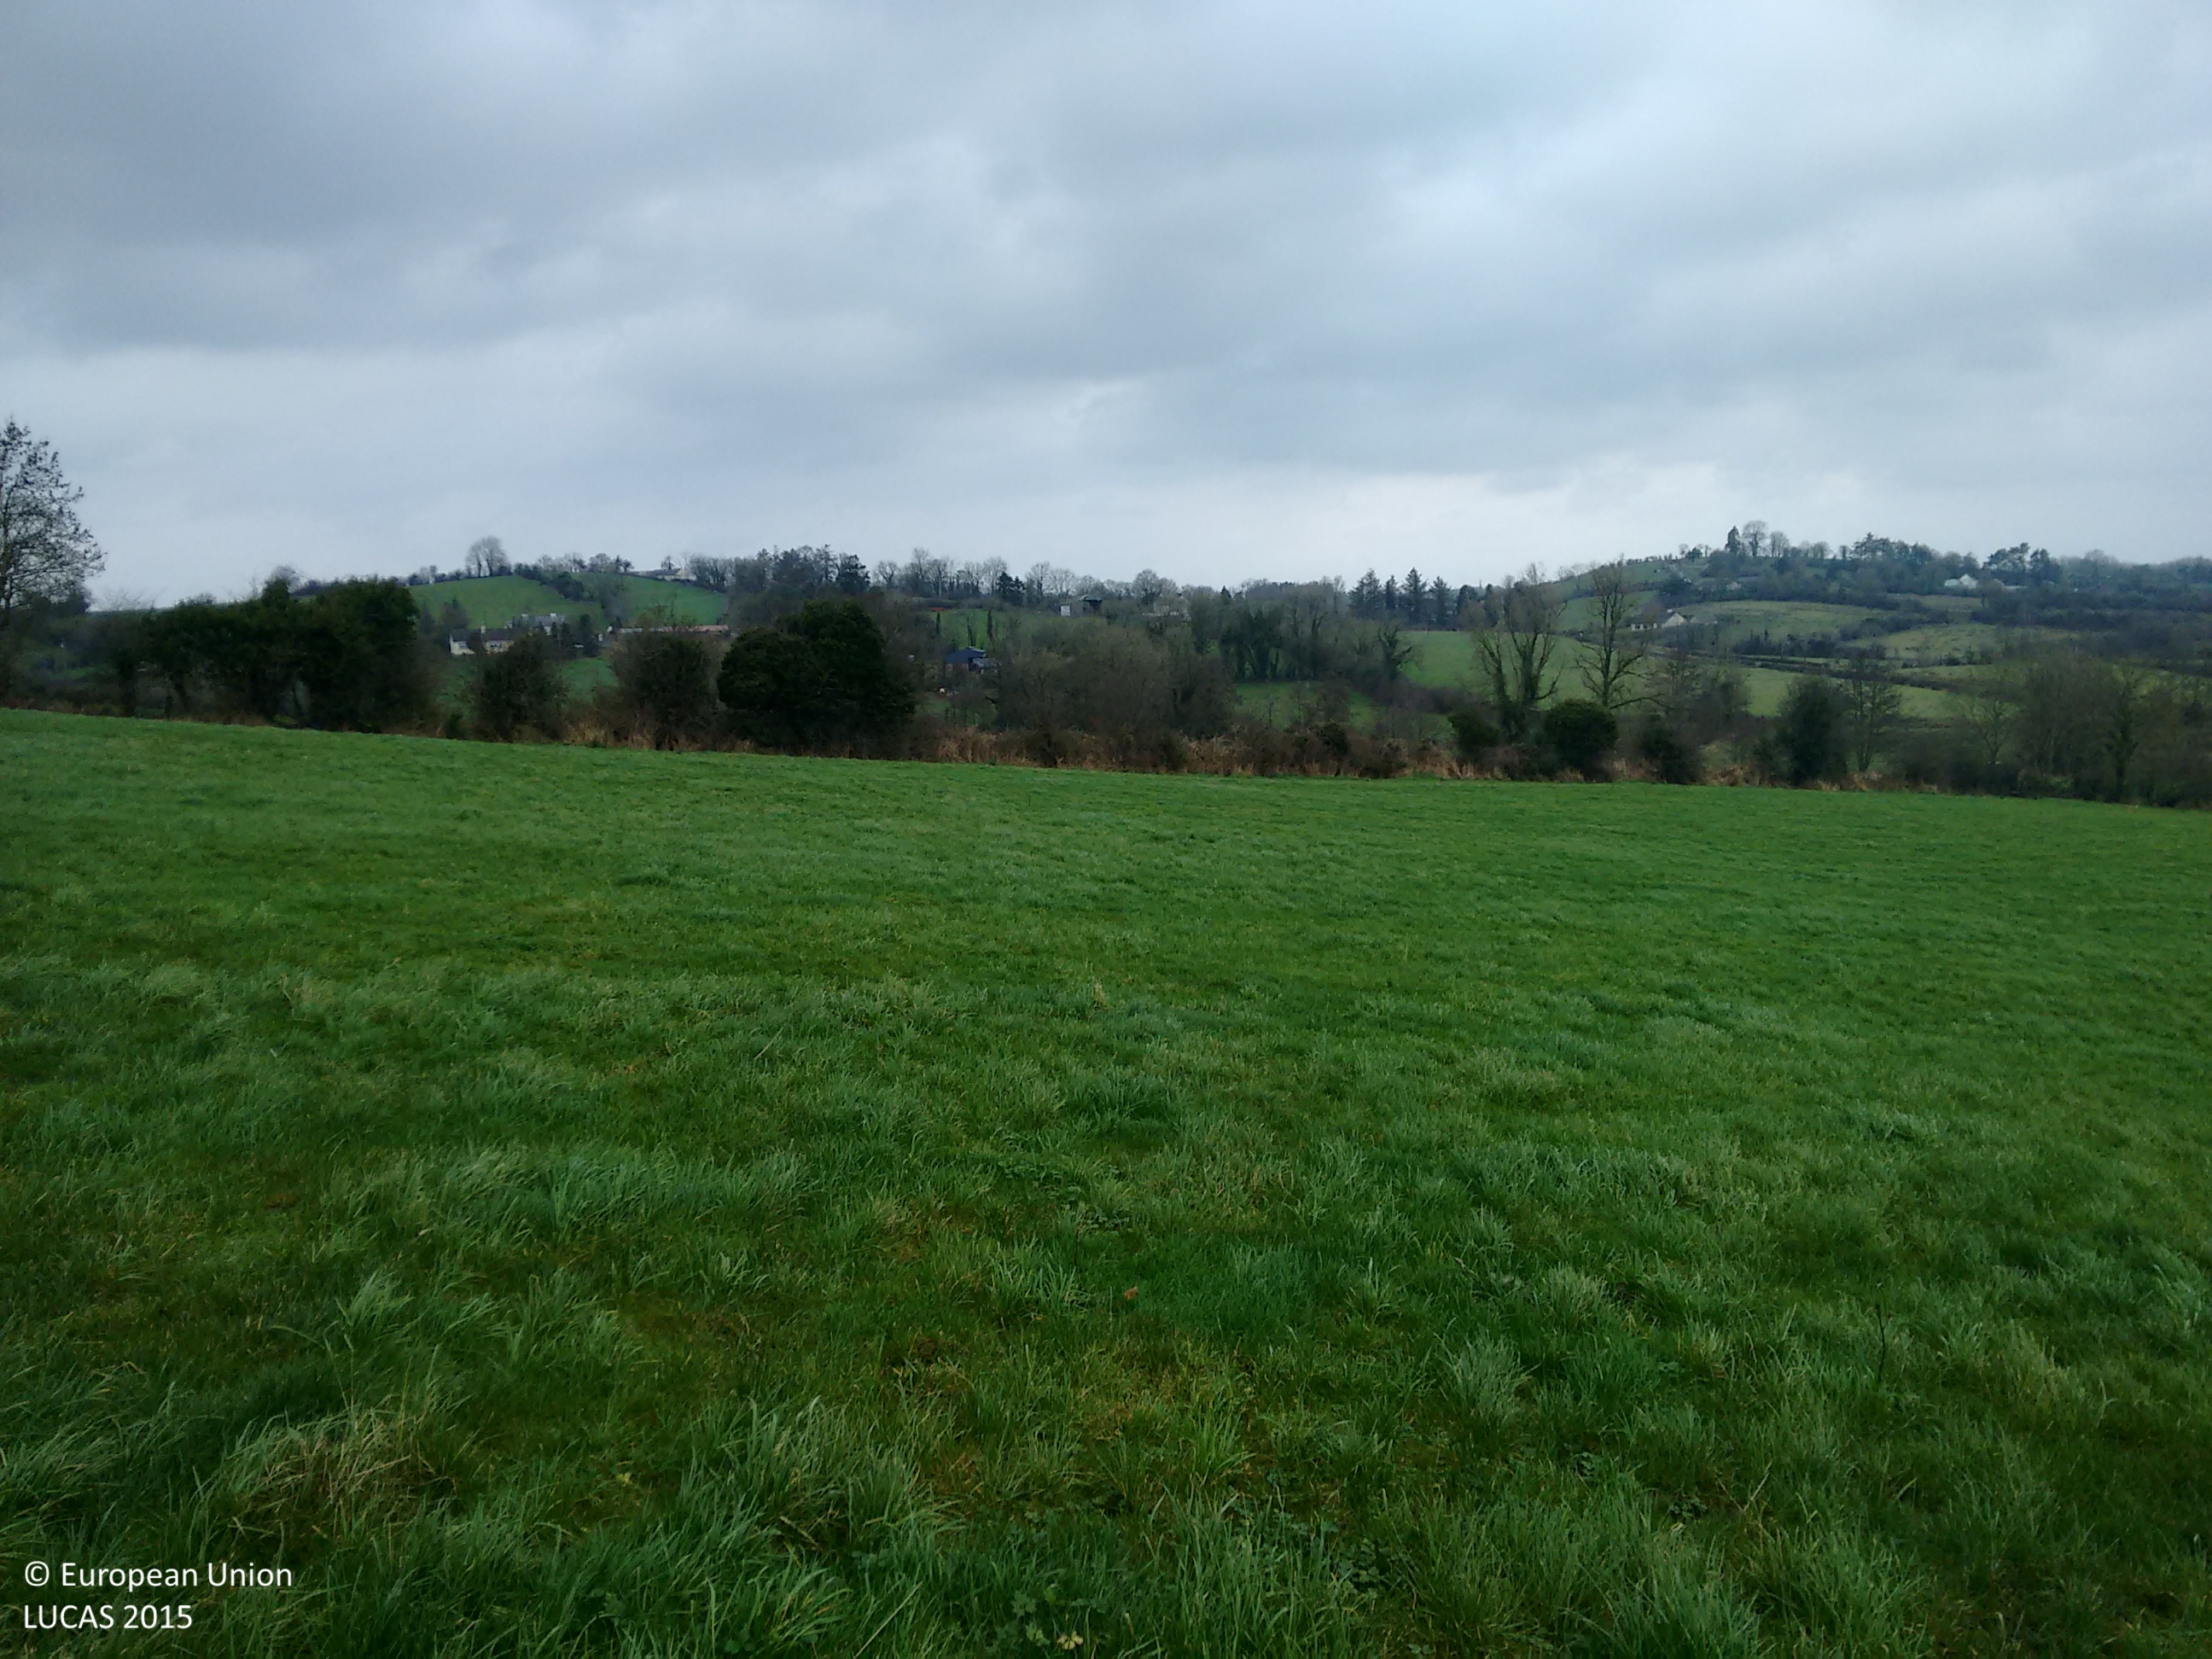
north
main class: Grassland
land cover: Grassland without tree/shrub cover
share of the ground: > 75 %
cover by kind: herbaceous plants 95 %, unconsolidated bare surface 5 %
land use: Agriculture (excluding fallow land and kitchen gardens)
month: December
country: IE
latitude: 54.0877
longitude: -7.2243
